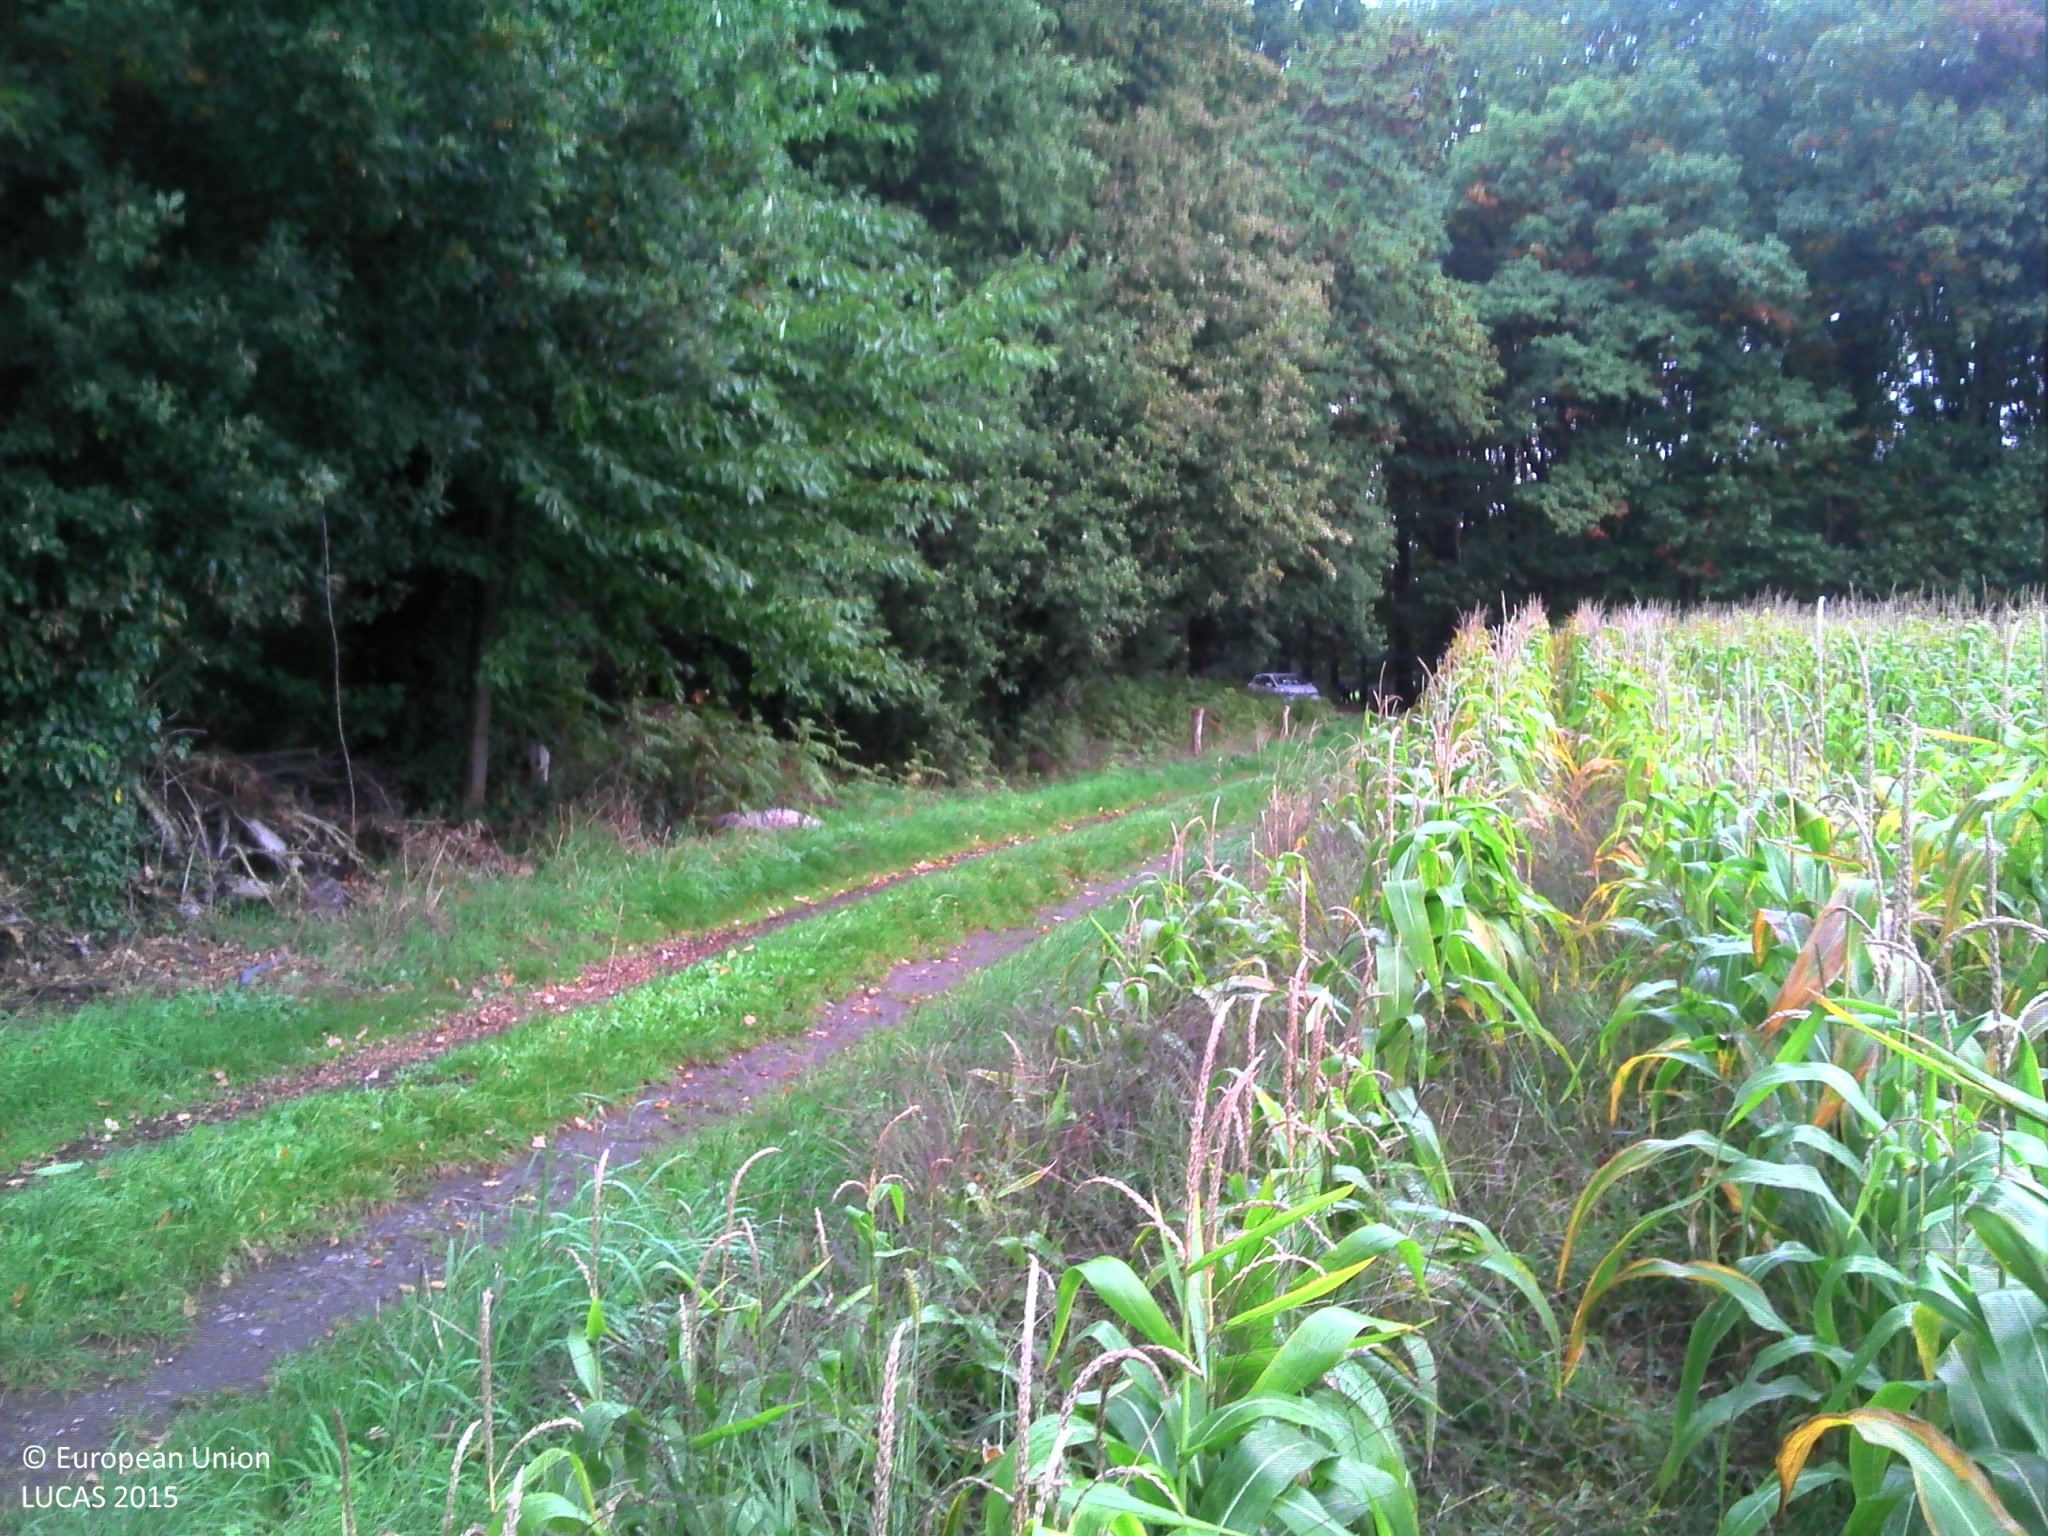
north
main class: Cropland
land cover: Maize
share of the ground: > 75 %
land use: Agriculture (excluding fallow land and kitchen gardens)
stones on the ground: < 10 %
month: October
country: BE
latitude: 51.1086
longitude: 4.7545
